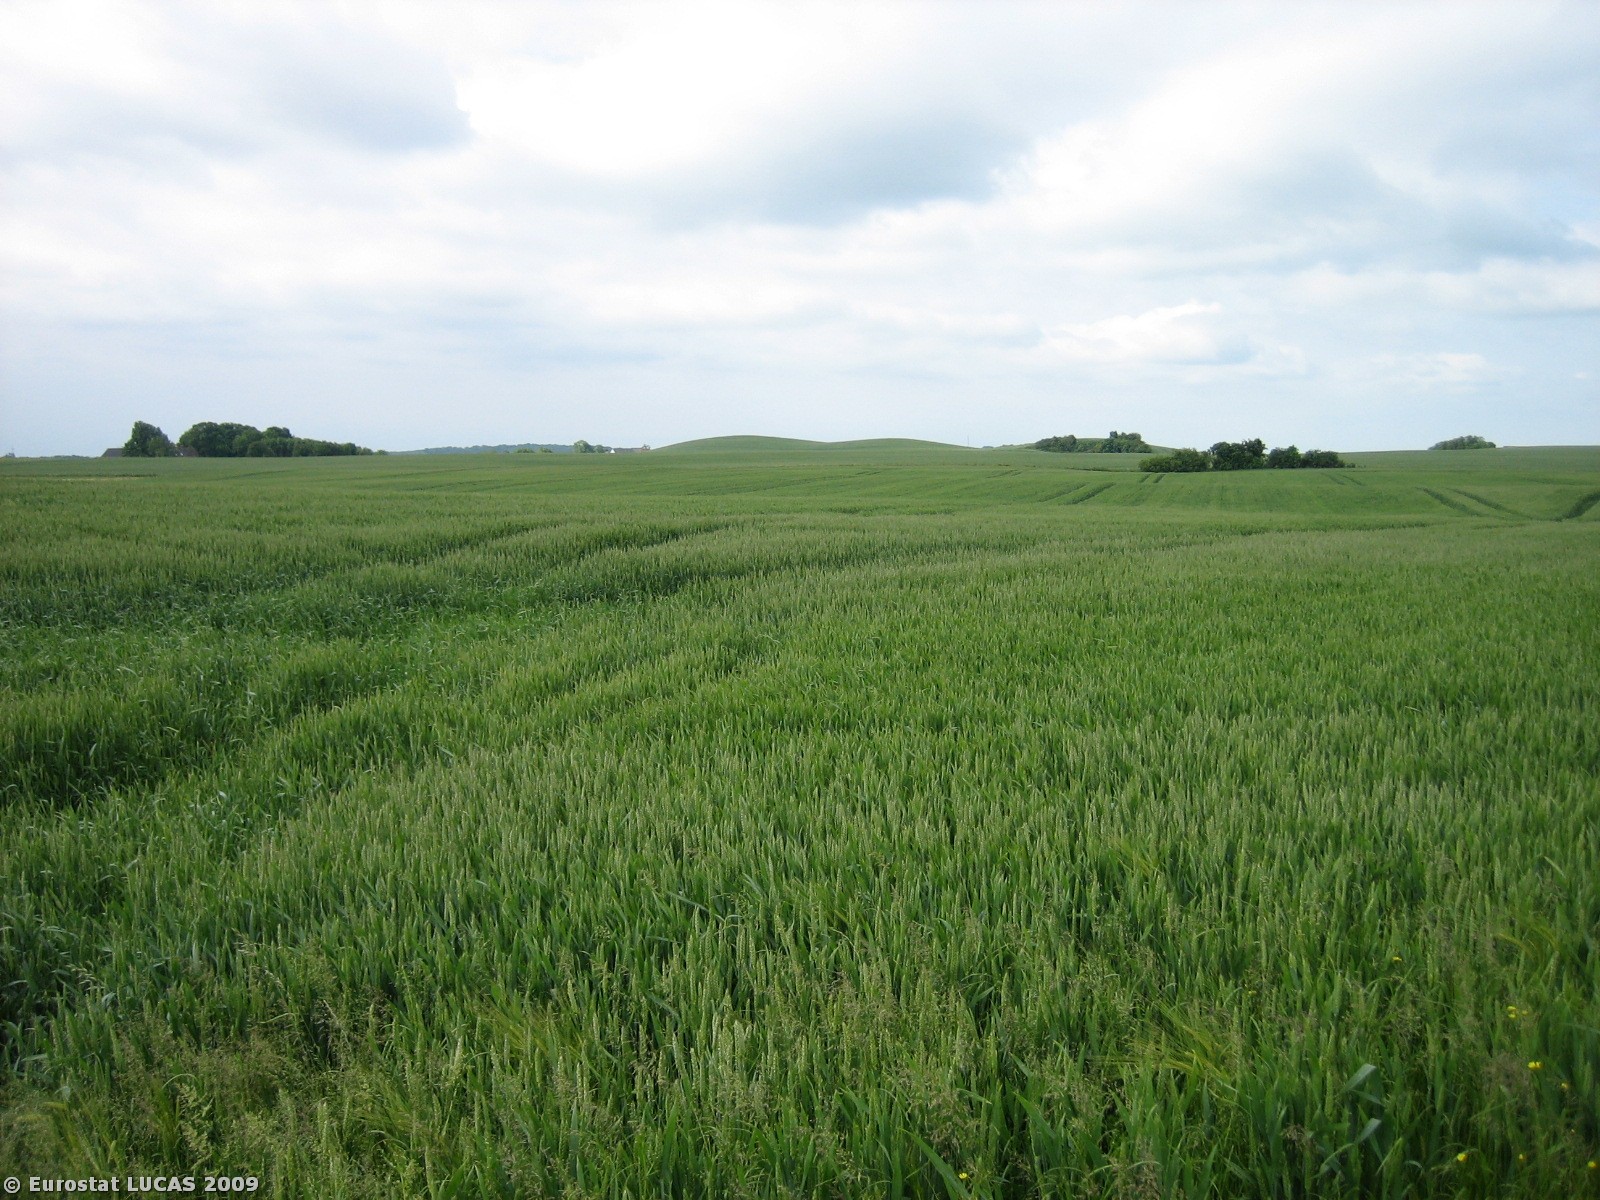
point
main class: Cropland
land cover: Common wheat
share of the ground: > 75 %
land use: Agriculture (excluding fallow land and kitchen gardens)
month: June
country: DK
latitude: 55.9361
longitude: 10.0160
